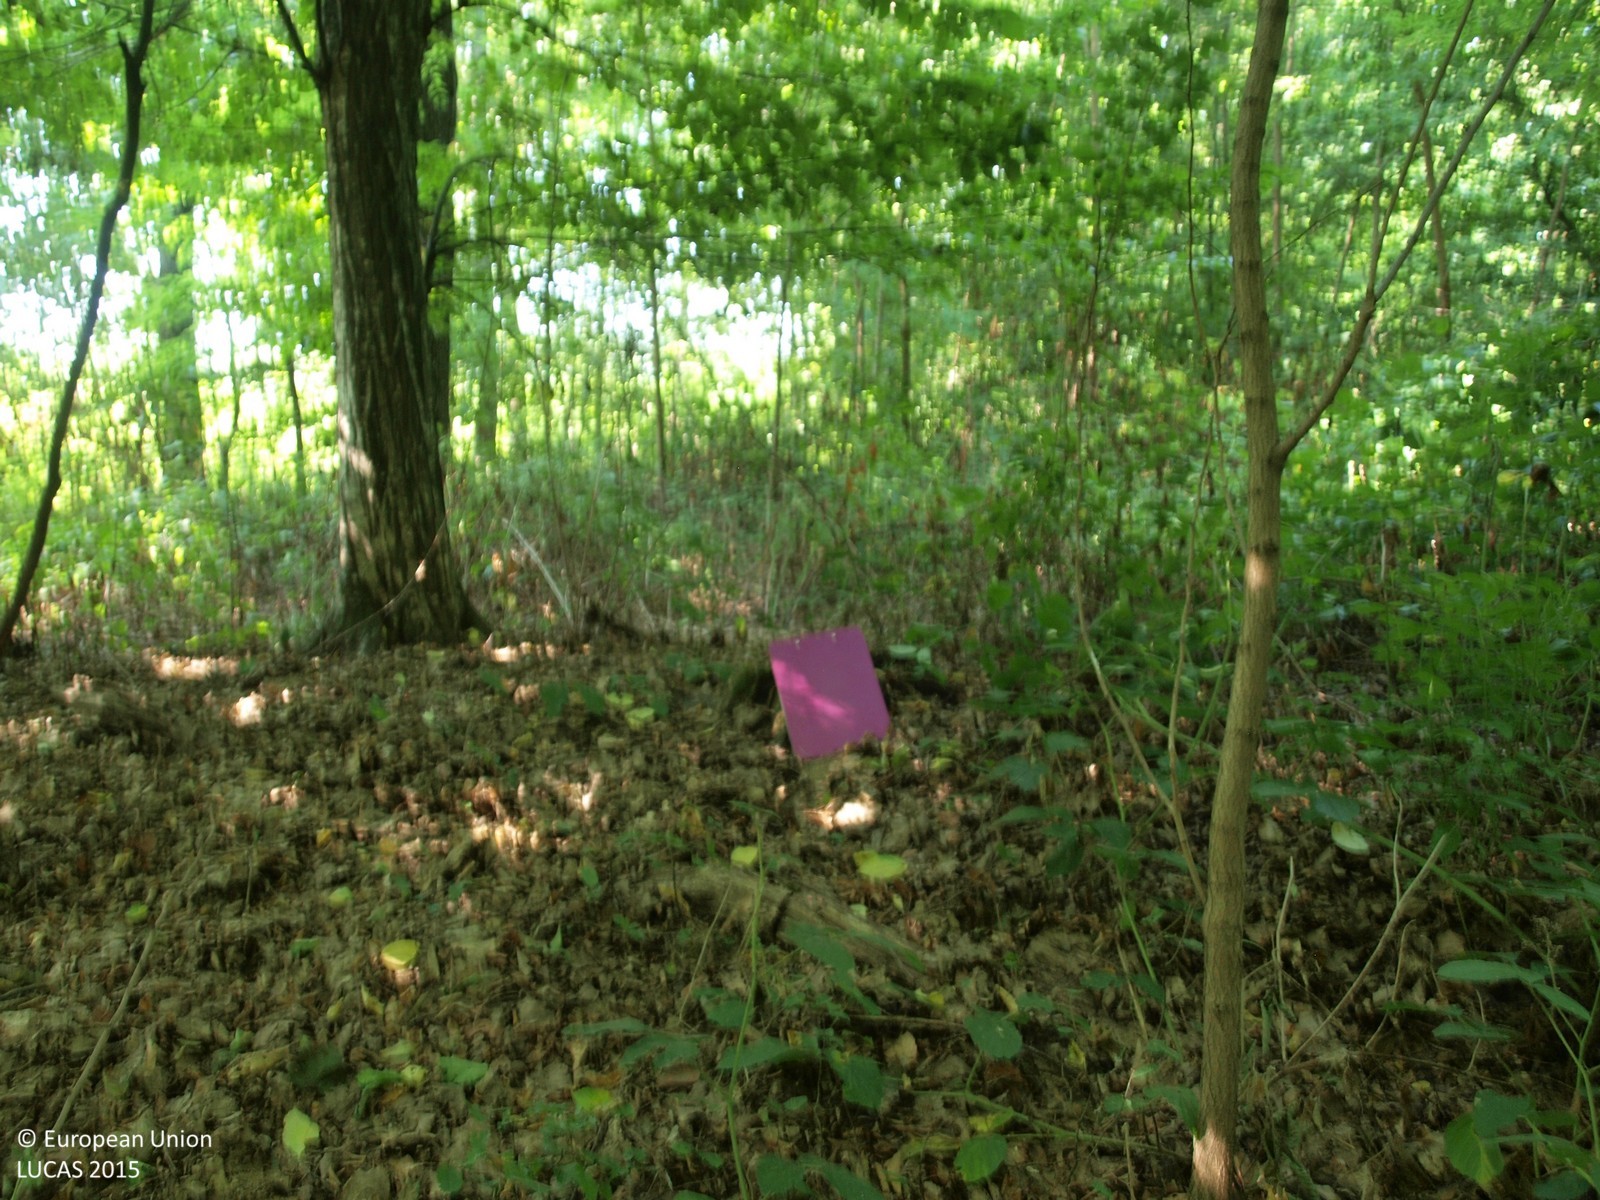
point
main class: Woodland
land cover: Broadleaved woodland
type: mesophytic deciduous forest
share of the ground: > 75 %
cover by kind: broadleaved forest trees 100 %
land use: Forestry
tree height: > 5 m
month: August
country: HR
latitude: 45.9522
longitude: 16.5407
